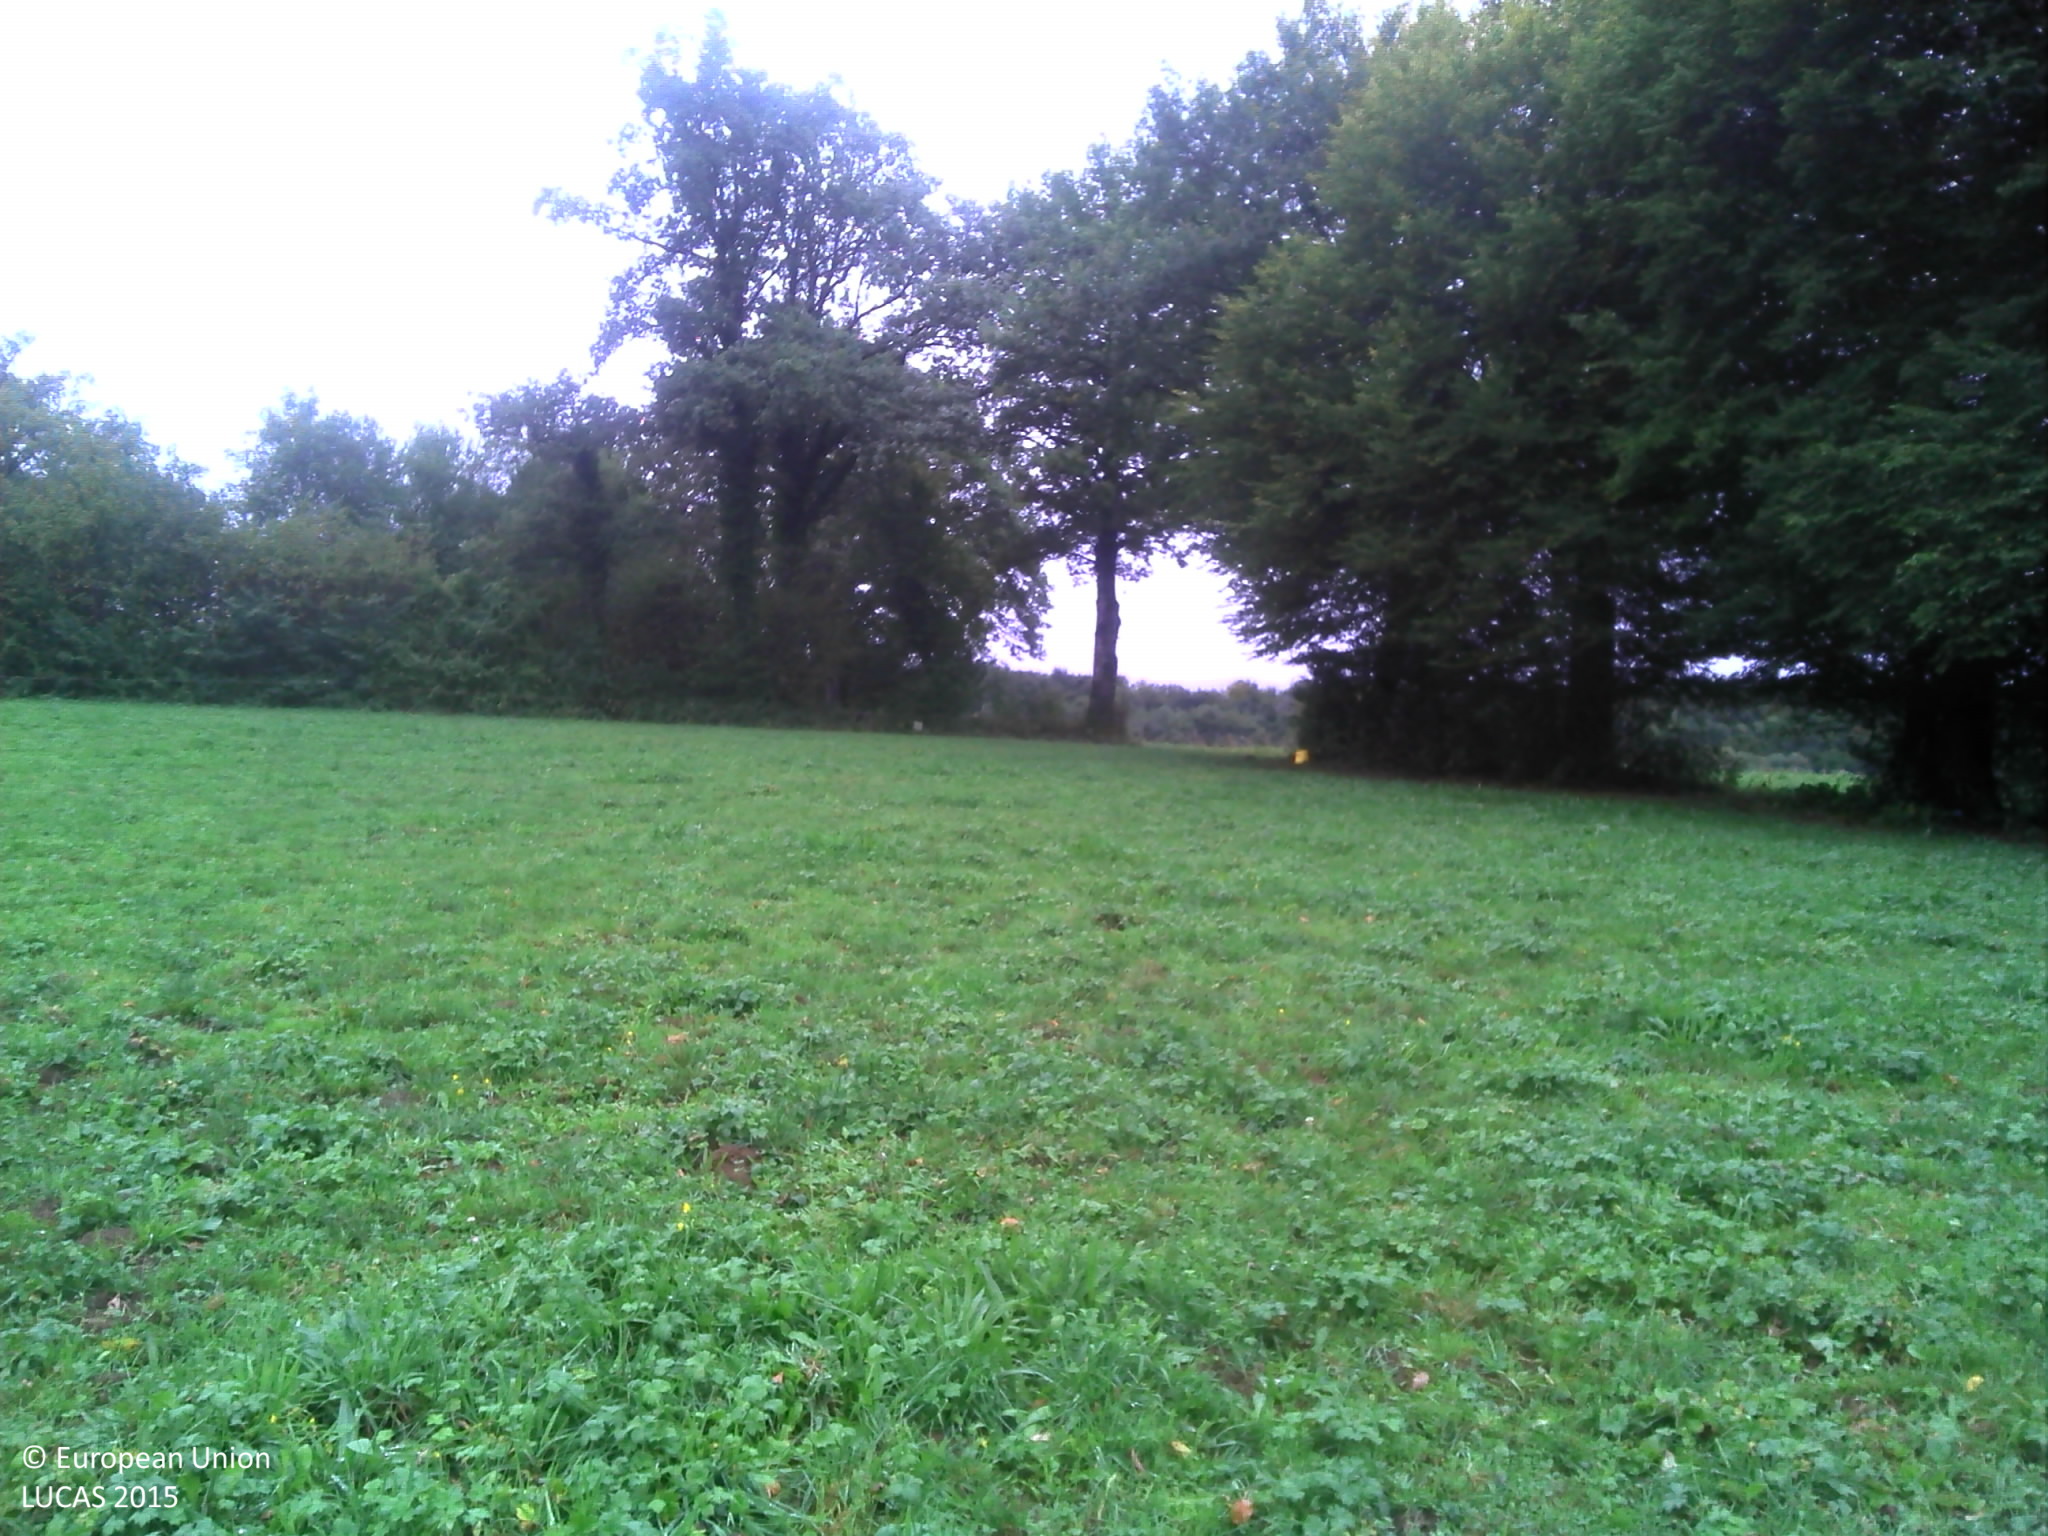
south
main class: Grassland
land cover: Grassland without tree/shrub cover
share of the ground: > 75 %
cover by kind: herbaceous plants 95 %, unconsolidated bare surface 5 %
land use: Agriculture (excluding fallow land and kitchen gardens)
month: September
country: FR
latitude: 47.1505
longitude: 6.2434
